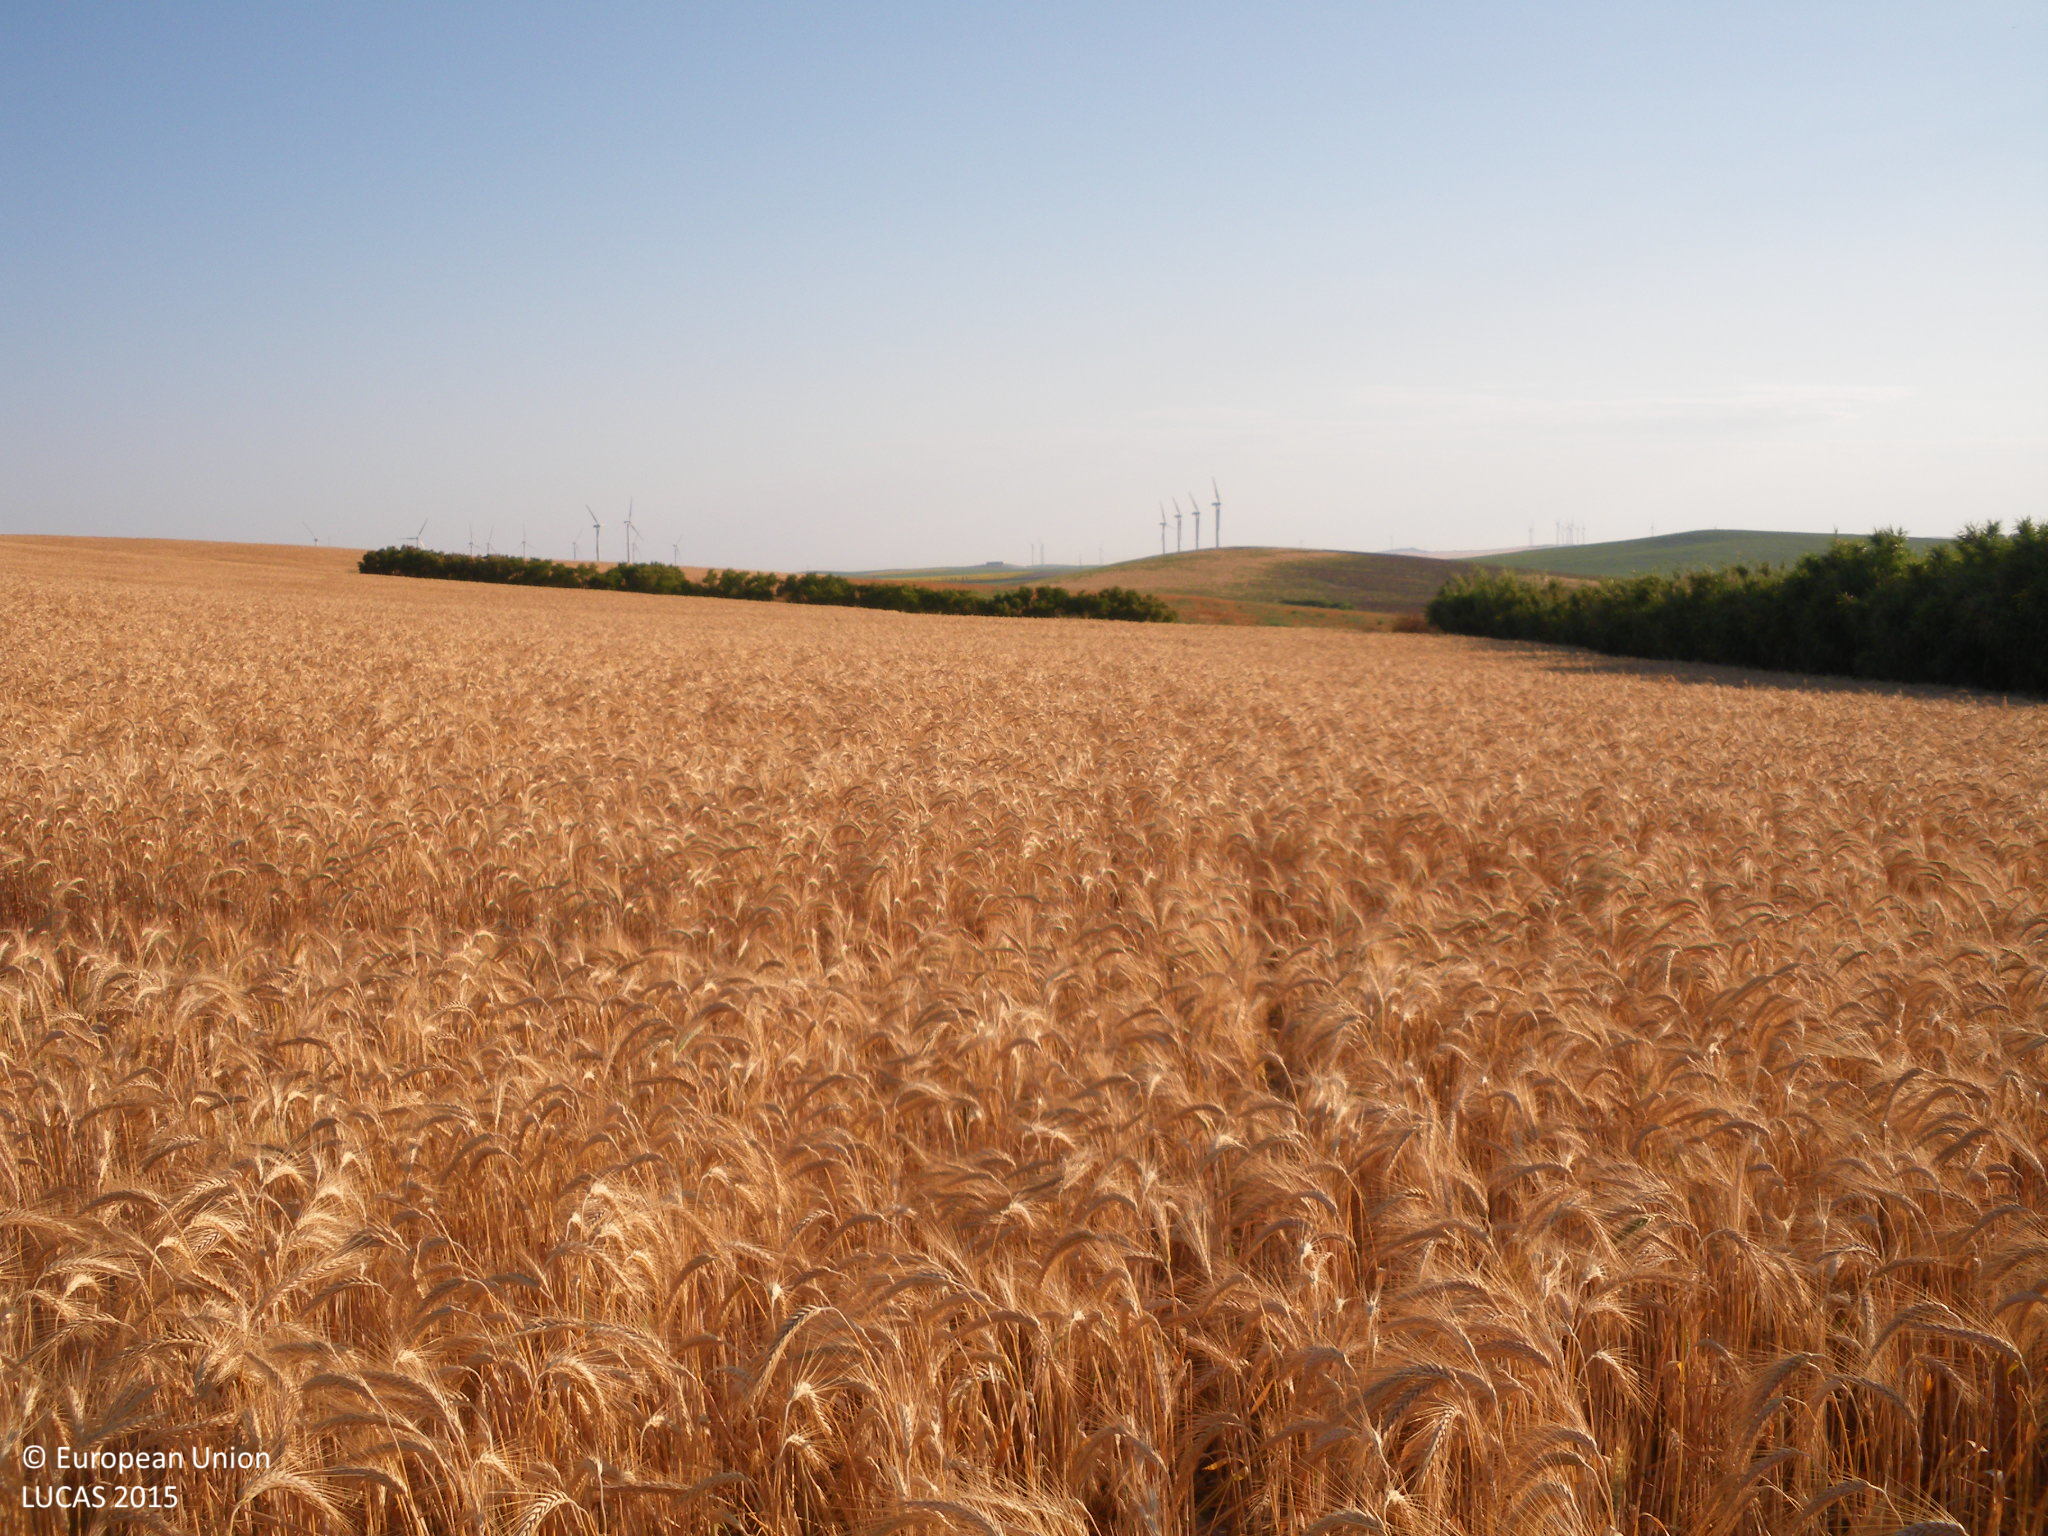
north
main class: Cropland
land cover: Barley
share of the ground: > 75 %
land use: Agriculture (excluding fallow land and kitchen gardens)
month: May
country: ES
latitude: 36.7036
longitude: -6.2794
